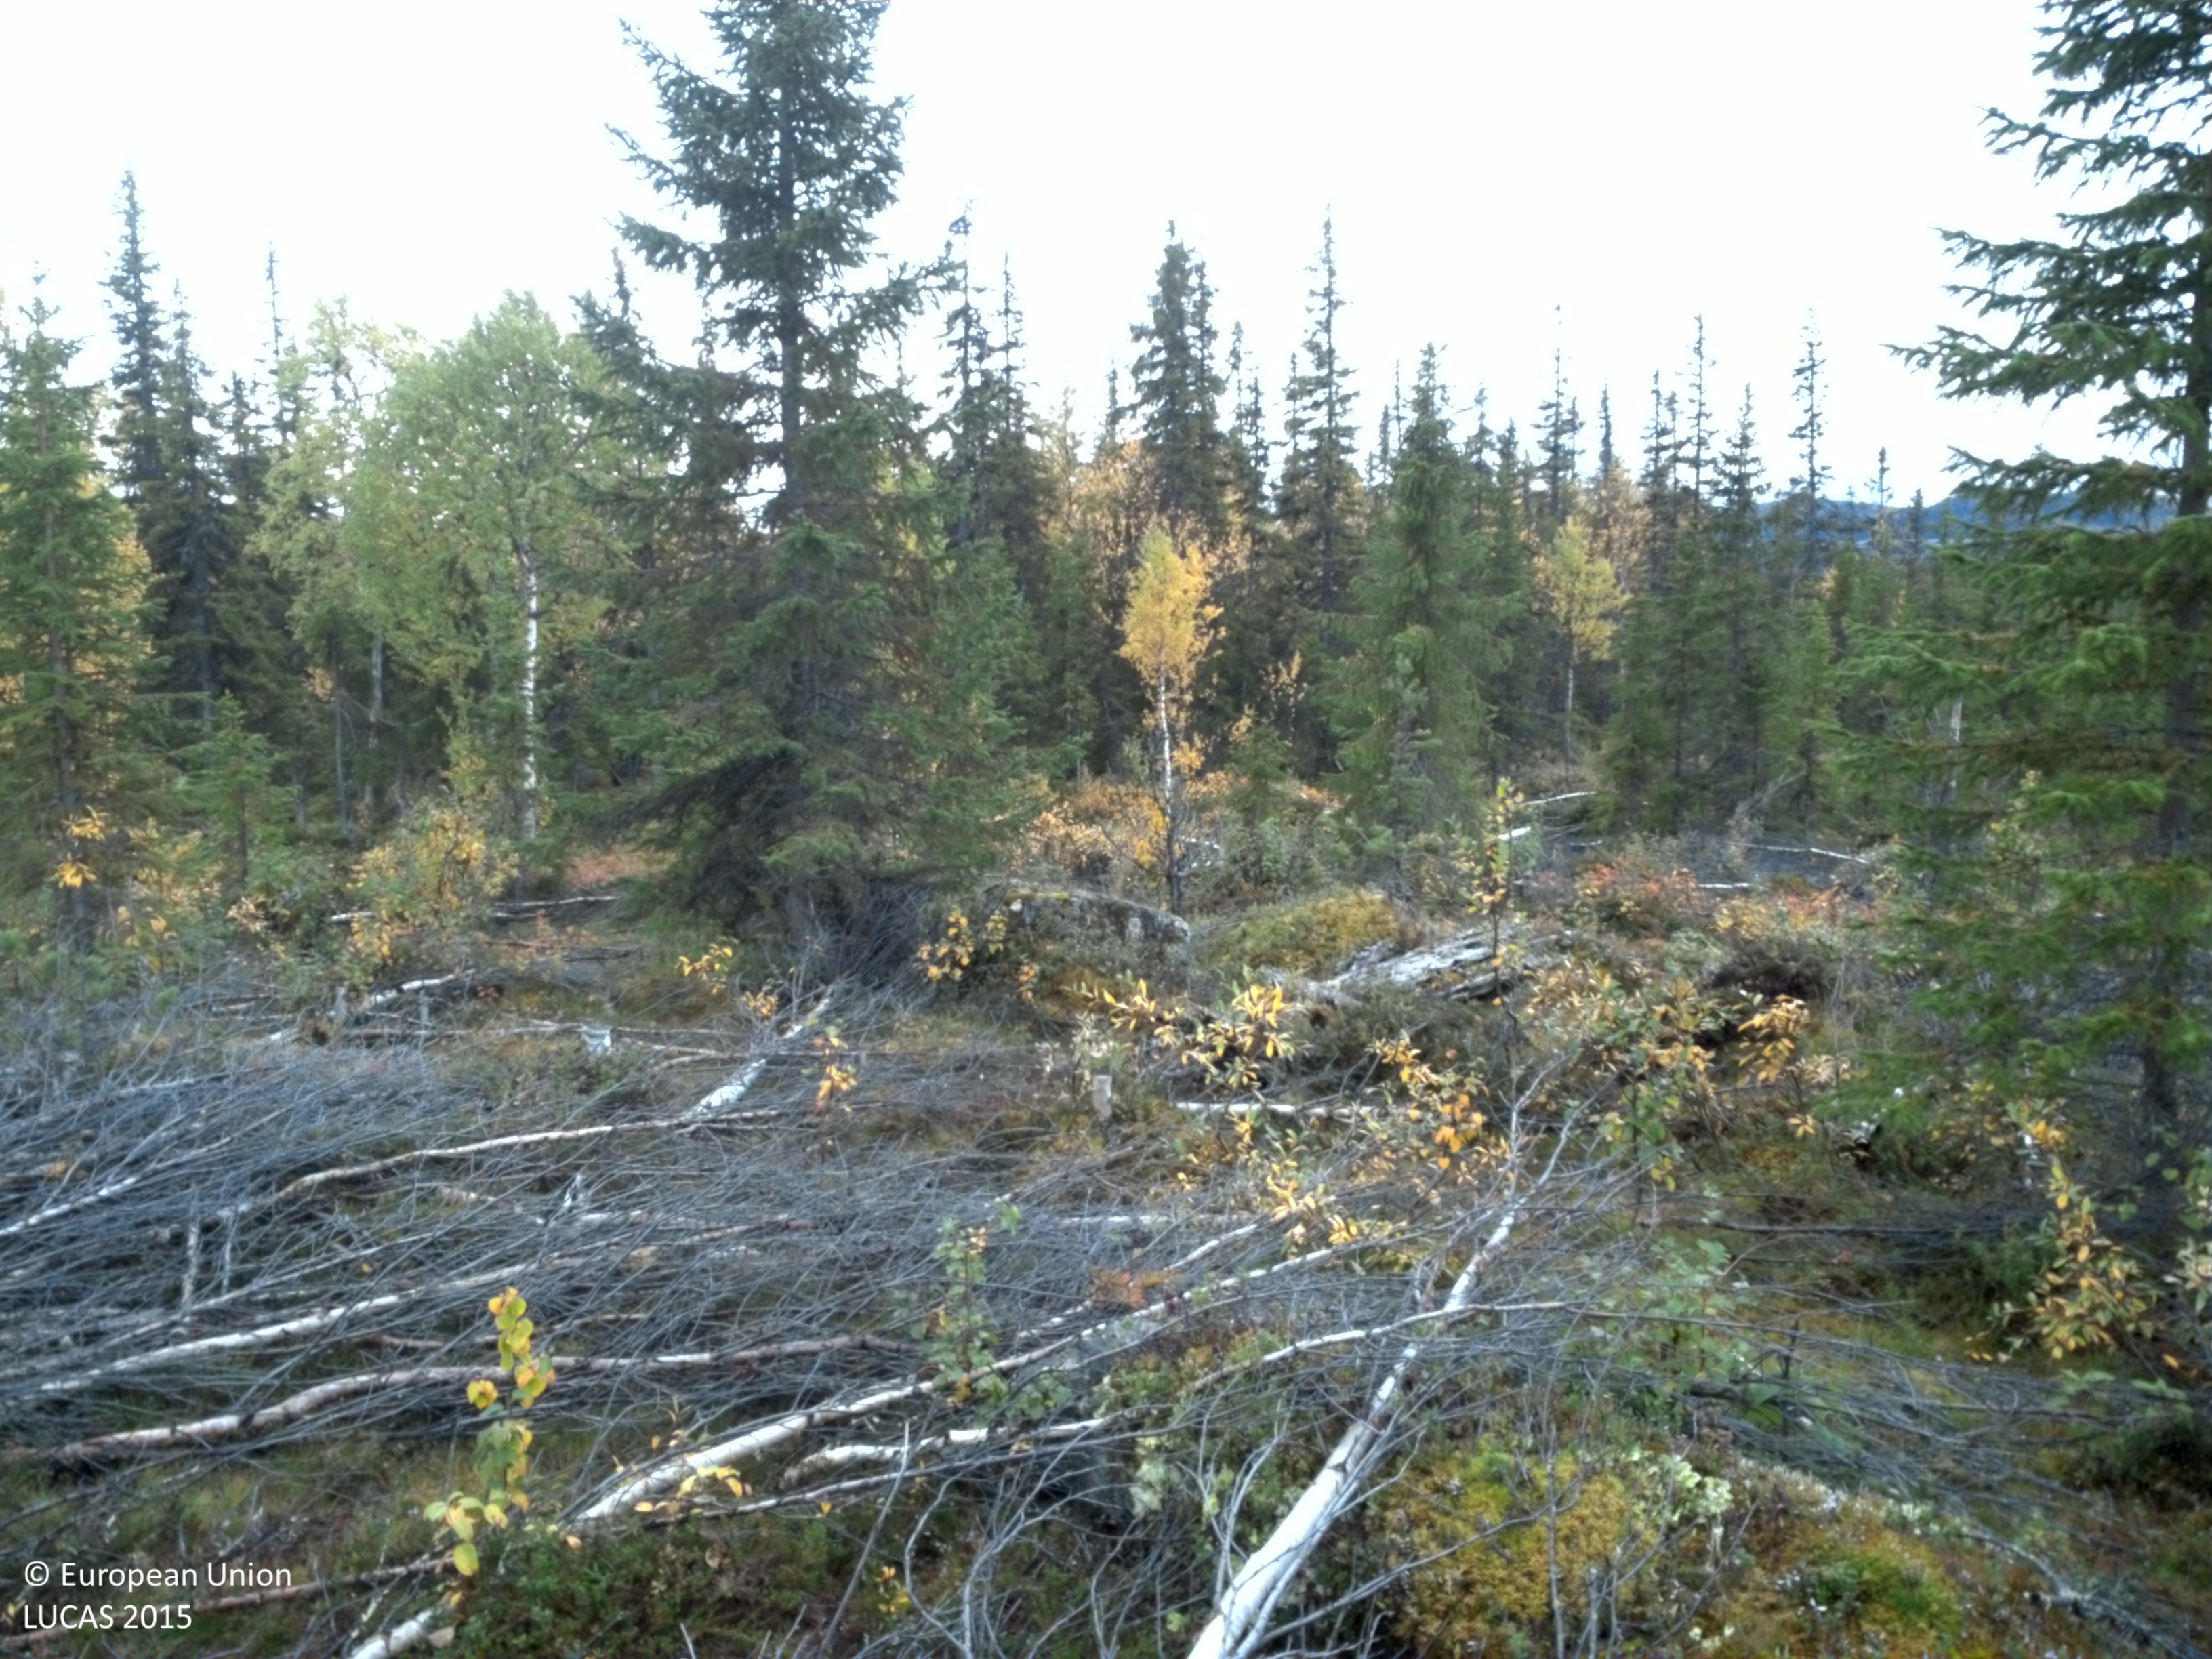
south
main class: Woodland
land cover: Spruce dominated coniferous woodland
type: boreal forest
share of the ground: 10 - 25 %
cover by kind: shrubs 40 %, lichens and mosses 20 %, herbaceous plants 15 %, coniferous forest trees 10 %
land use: Forestry
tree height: > 5 m
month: September
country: SE
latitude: 65.4030
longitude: 16.1425
